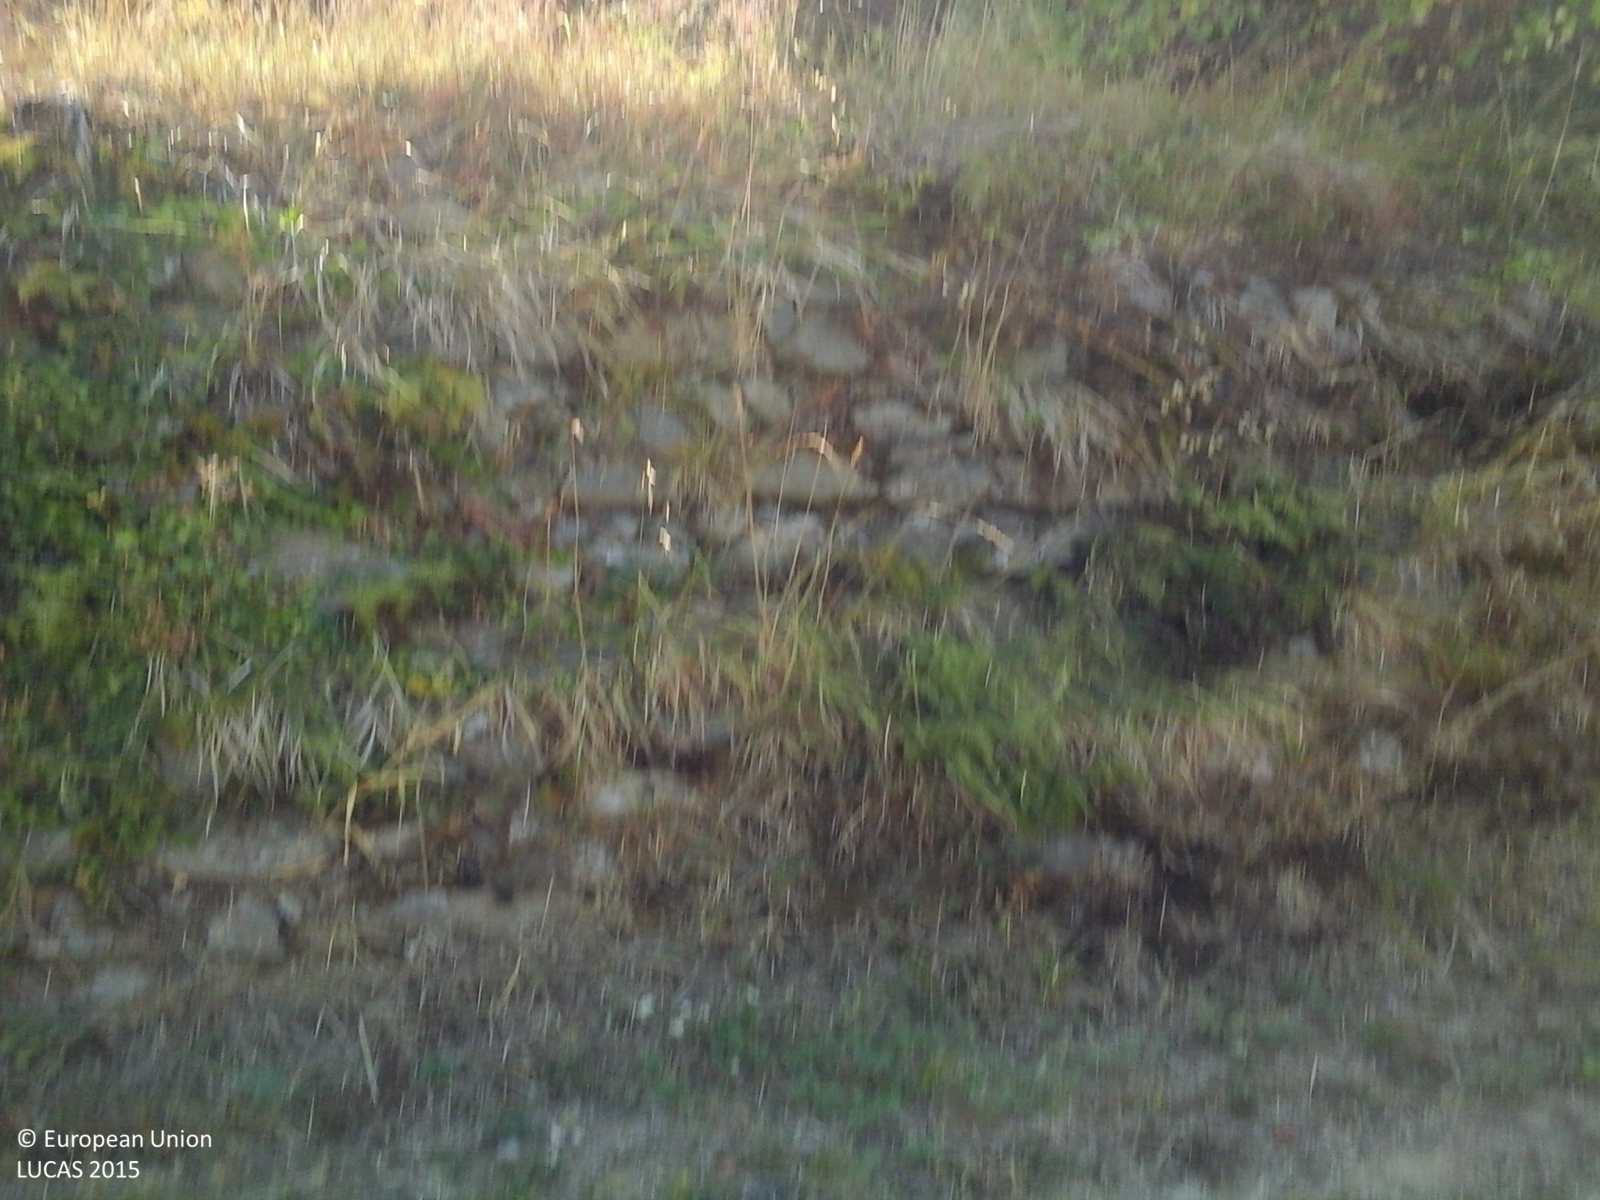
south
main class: Cropland
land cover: Olive groves
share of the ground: > 75 %
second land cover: Grassland without tree/shrub cover
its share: > 75 %
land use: Agriculture (excluding fallow land and kitchen gardens)
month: August
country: IT
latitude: 44.3308
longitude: 9.4120
